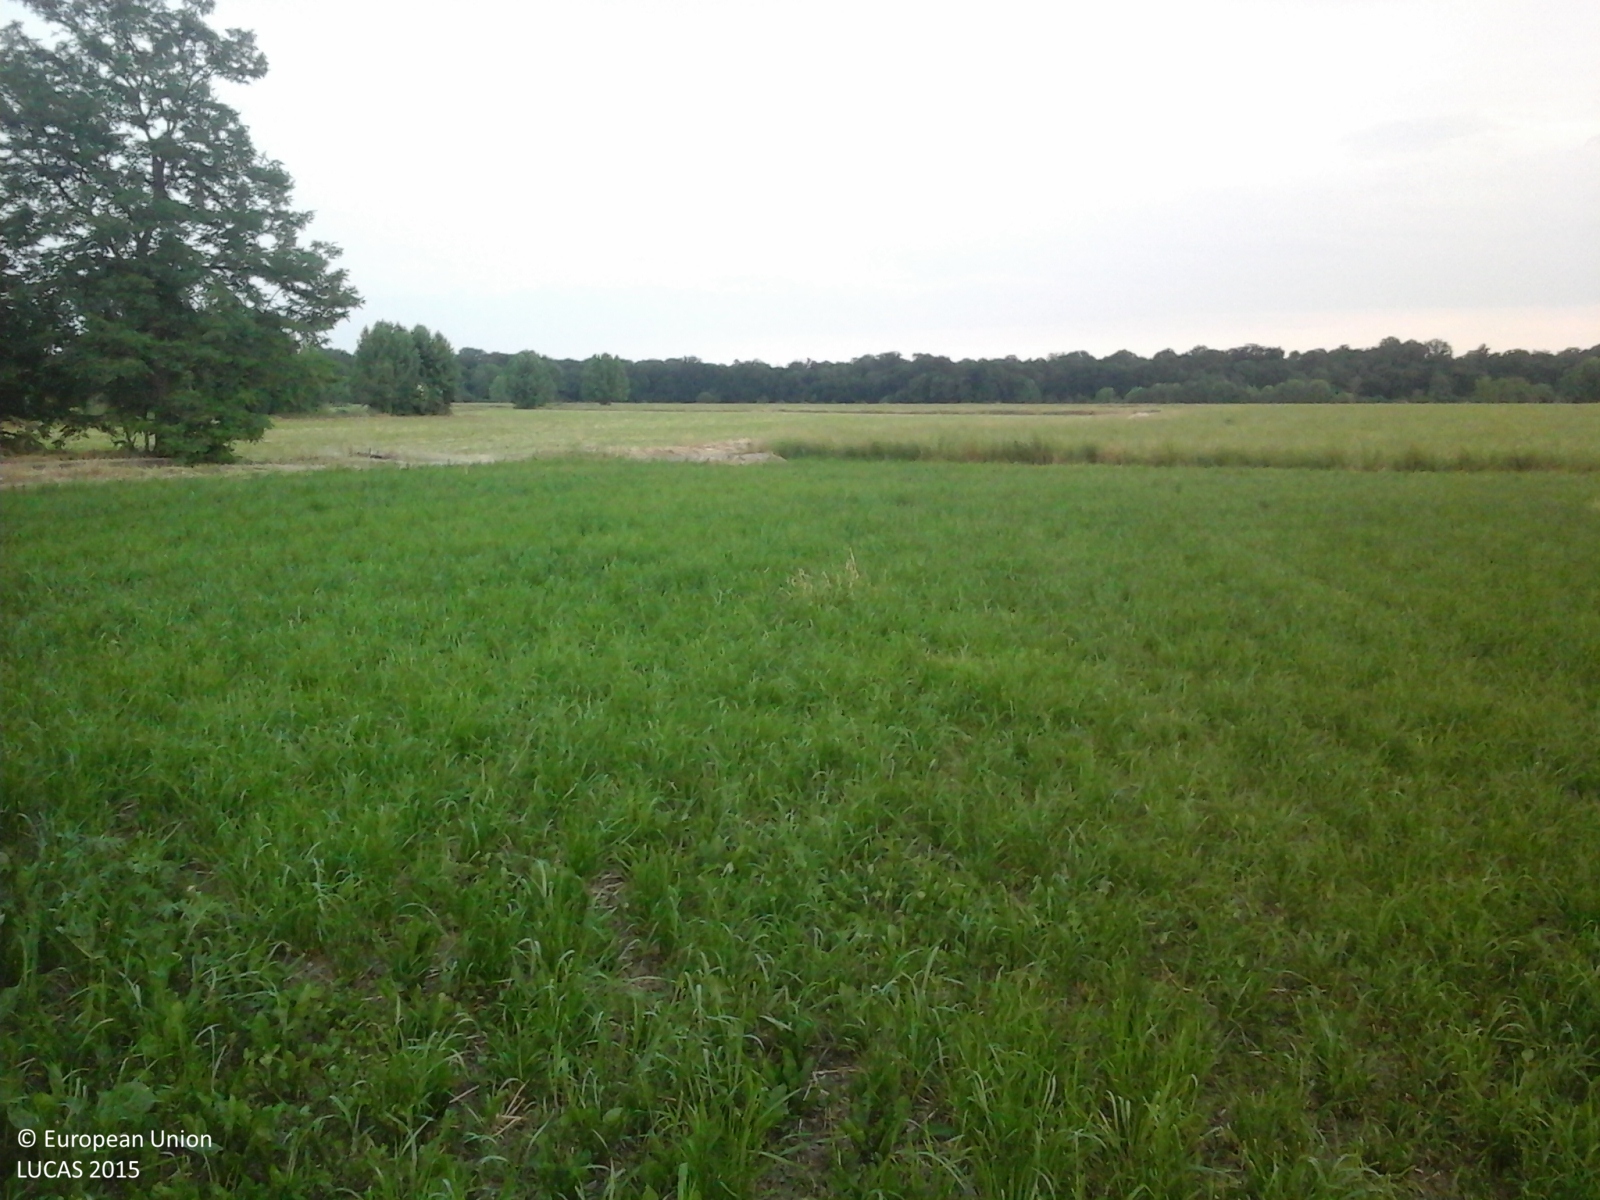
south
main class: Grassland
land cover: Grassland without tree/shrub cover
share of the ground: > 75 %
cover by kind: herbaceous plants 100 %
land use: Agriculture (excluding fallow land and kitchen gardens)
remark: Harvested field
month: May
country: IT
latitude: 45.2133
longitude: 10.7499
